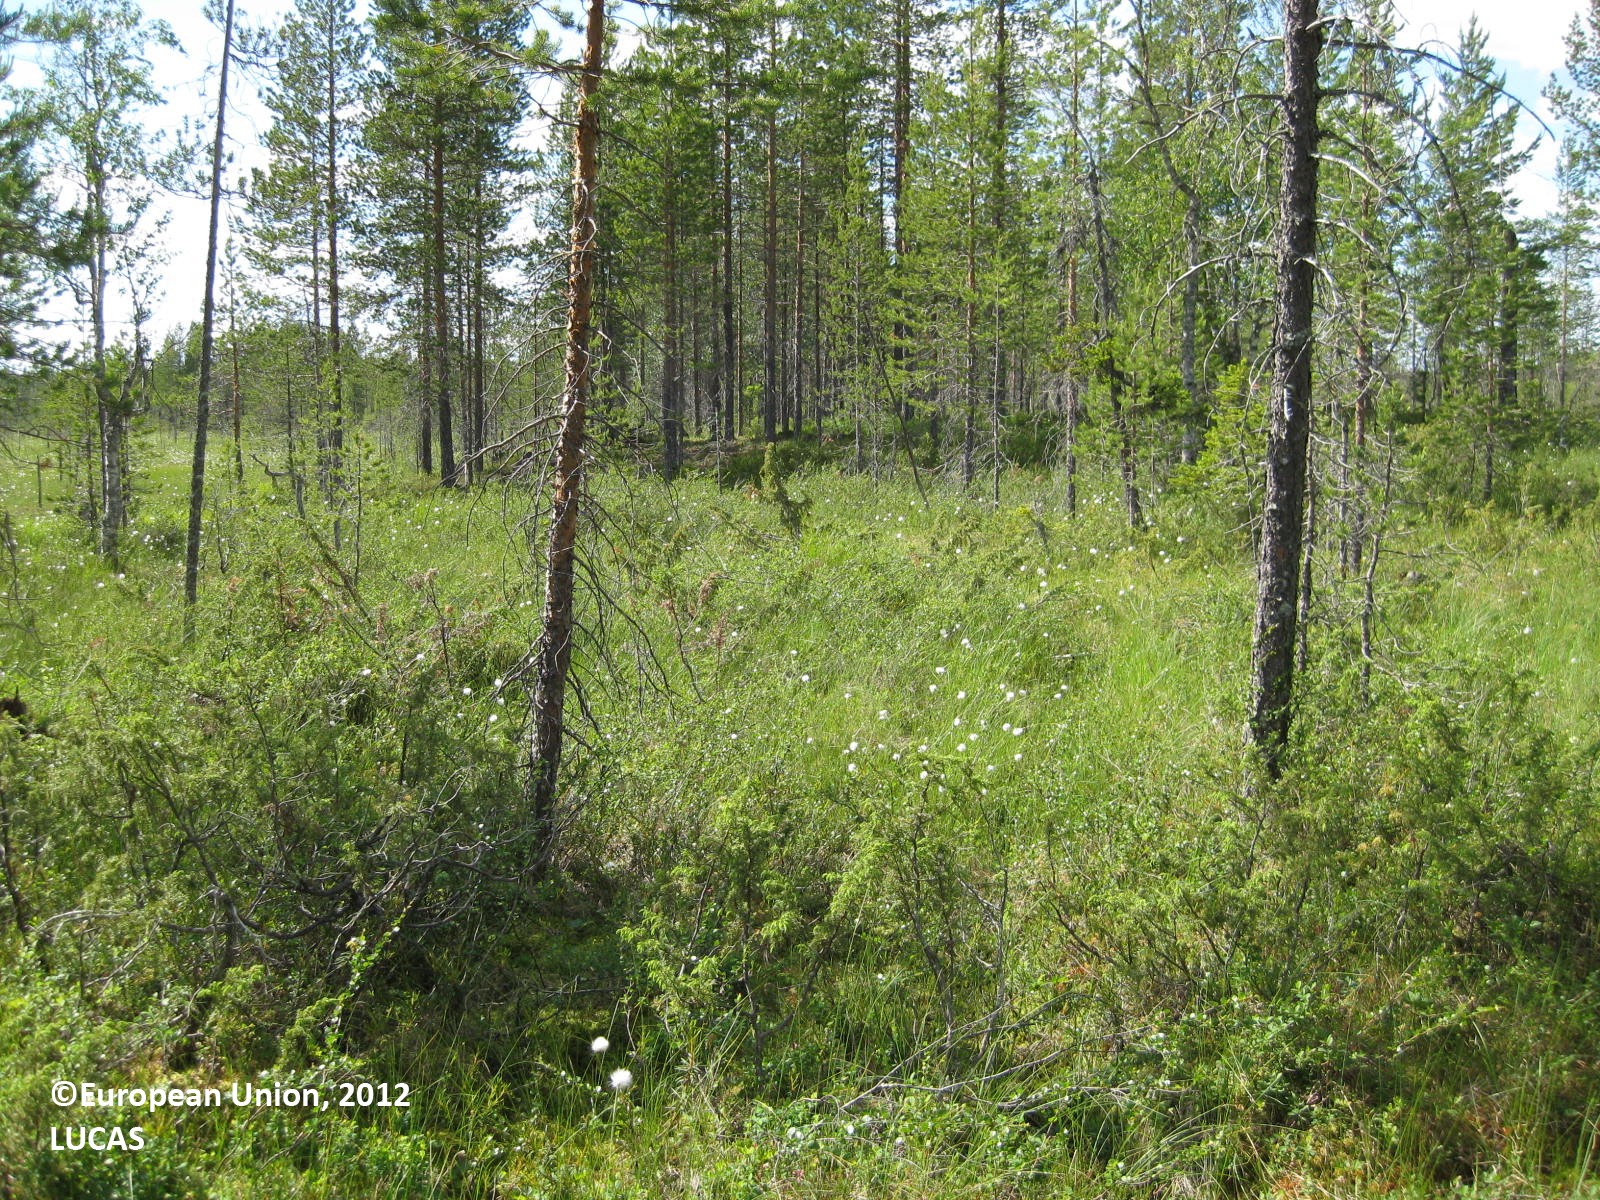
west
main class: Woodland
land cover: Pine dominated coniferous woodland
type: boreal forest
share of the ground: 50 - 75 %
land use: Forestry
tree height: > 5 m
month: July
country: FI
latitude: 65.5223
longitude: 29.4238
